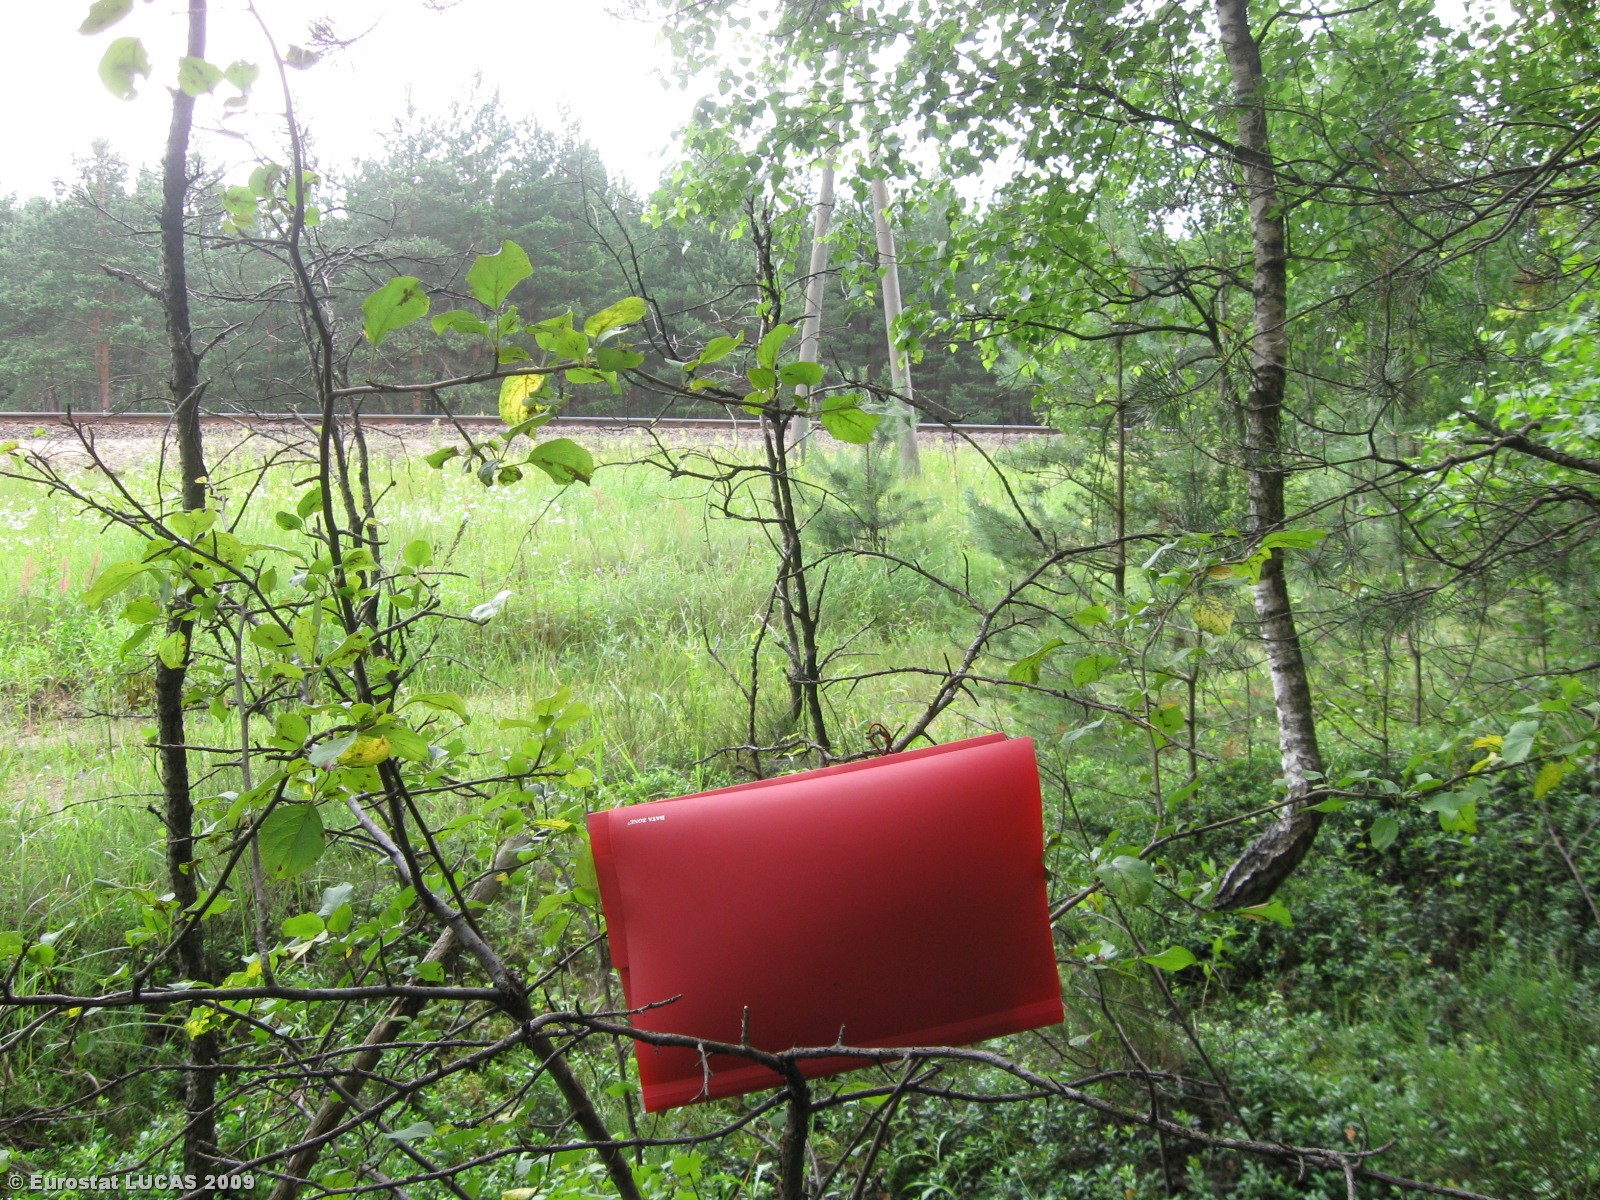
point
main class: Woodland
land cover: Mixed woodland
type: hemiboreal forest and nemoral coniferous forest and mixed broadleaved-coniferous forest
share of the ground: > 75 %
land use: Forestry
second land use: Amenities, museums, leisure
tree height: > 5 m
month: July
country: LT
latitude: 54.5874
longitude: 25.2708
